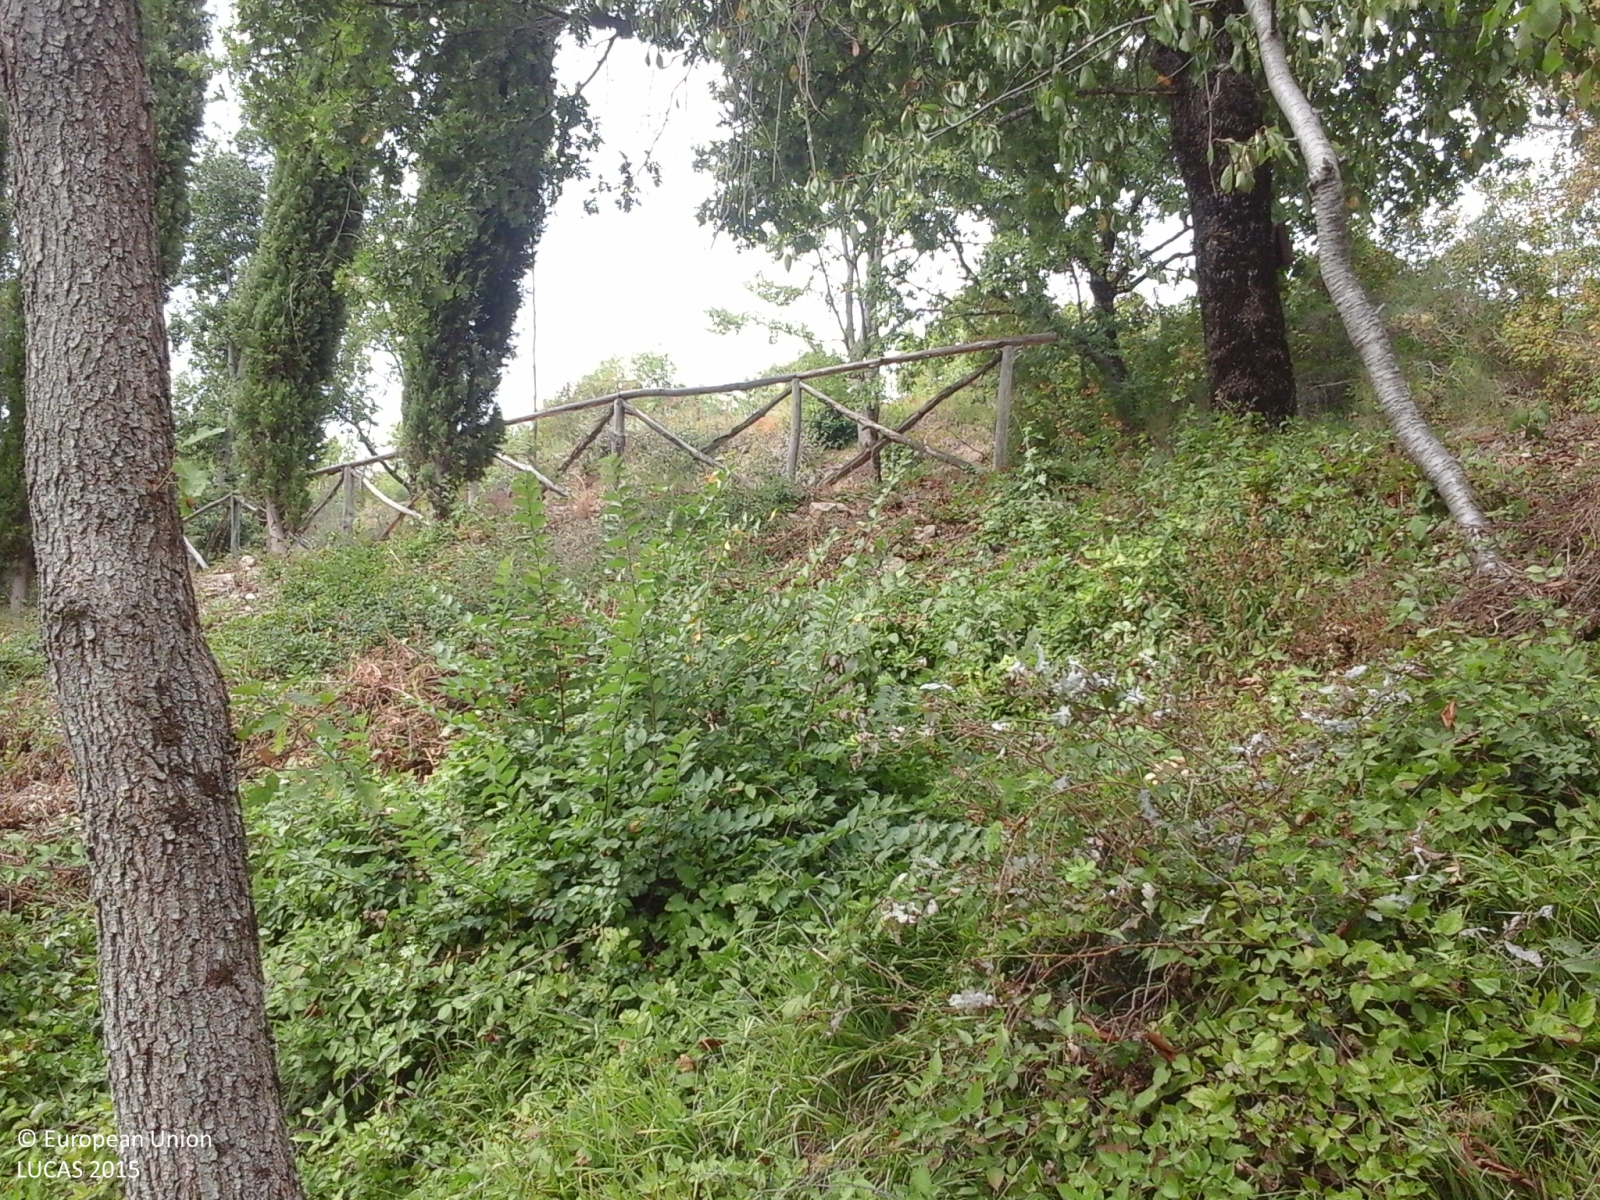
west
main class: Woodland
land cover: Broadleaved woodland
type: thermophilous deciduous forest
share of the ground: > 75 %
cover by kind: shrubs 40 %, broadleaved forest trees 35 %, herbaceous plants 25 %
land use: Forestry
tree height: < 5 m
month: October
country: IT
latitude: 43.3301
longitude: 12.3983
